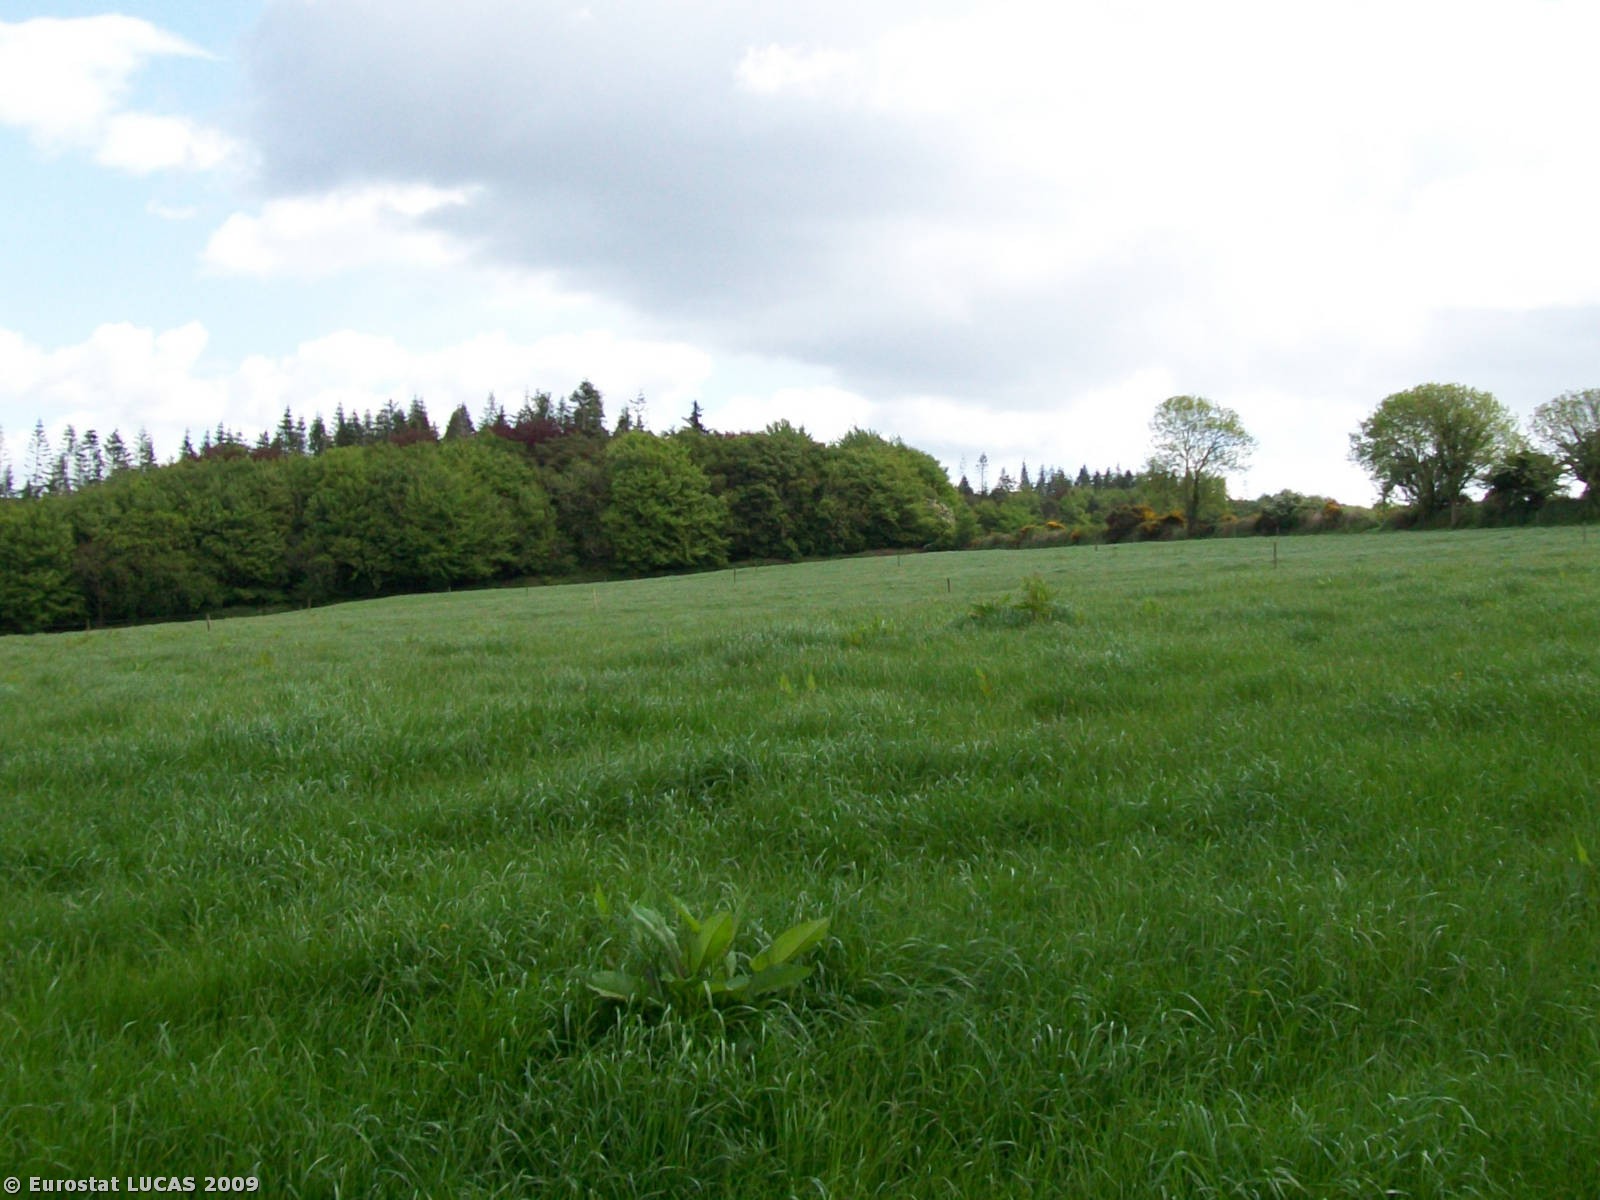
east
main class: Grassland
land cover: Grassland without tree/shrub cover
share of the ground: > 75 %
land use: Agriculture (excluding fallow land and kitchen gardens)
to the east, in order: Grassland without tree/shrub cover; Fences; Grassland without tree/shrub cover; Fences; Grassland without tree/shrub cover; Fences; Grassland without tree/shrub cover; Mixed woodland
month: May
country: IE
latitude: 51.7837
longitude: -8.7735
